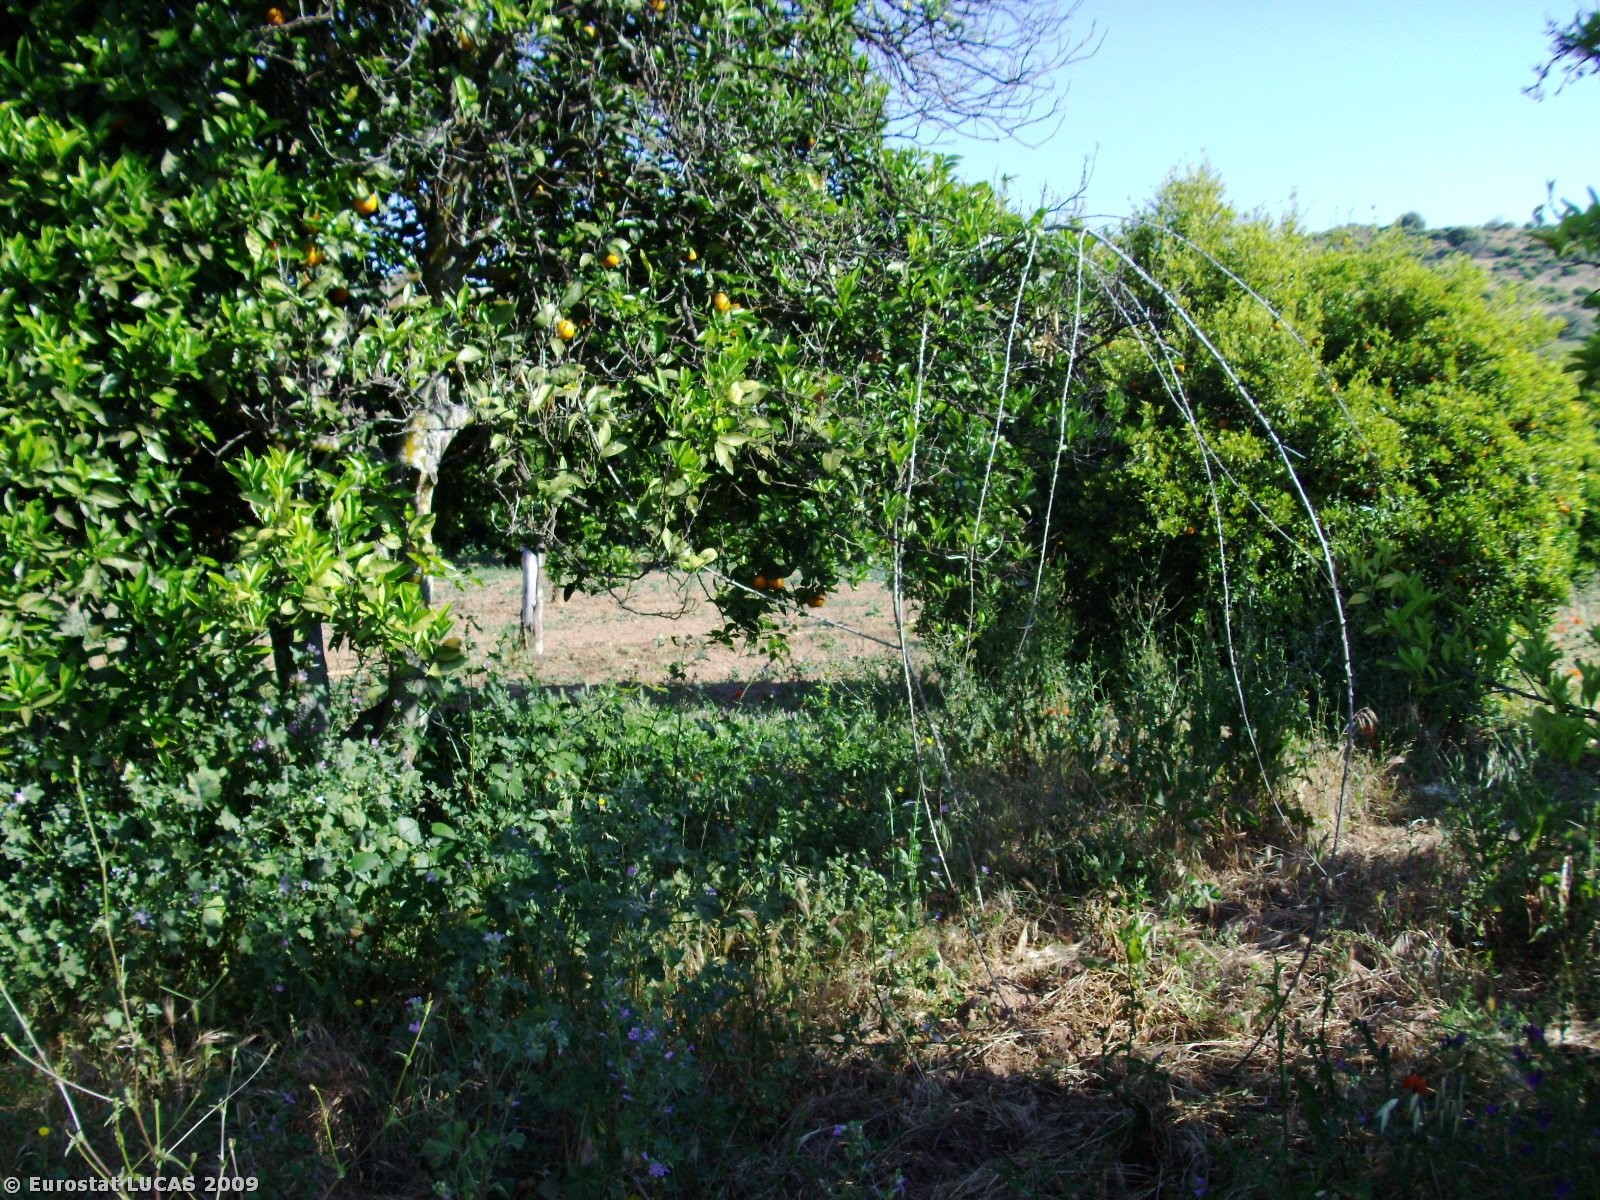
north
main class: Cropland
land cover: Oranges
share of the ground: 50 - 75 %
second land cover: Spontaneously vegetated surfaces
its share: 10 - 25 %
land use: Agriculture (excluding fallow land and kitchen gardens)
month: May
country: PT
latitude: 37.2634
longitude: -7.4703
